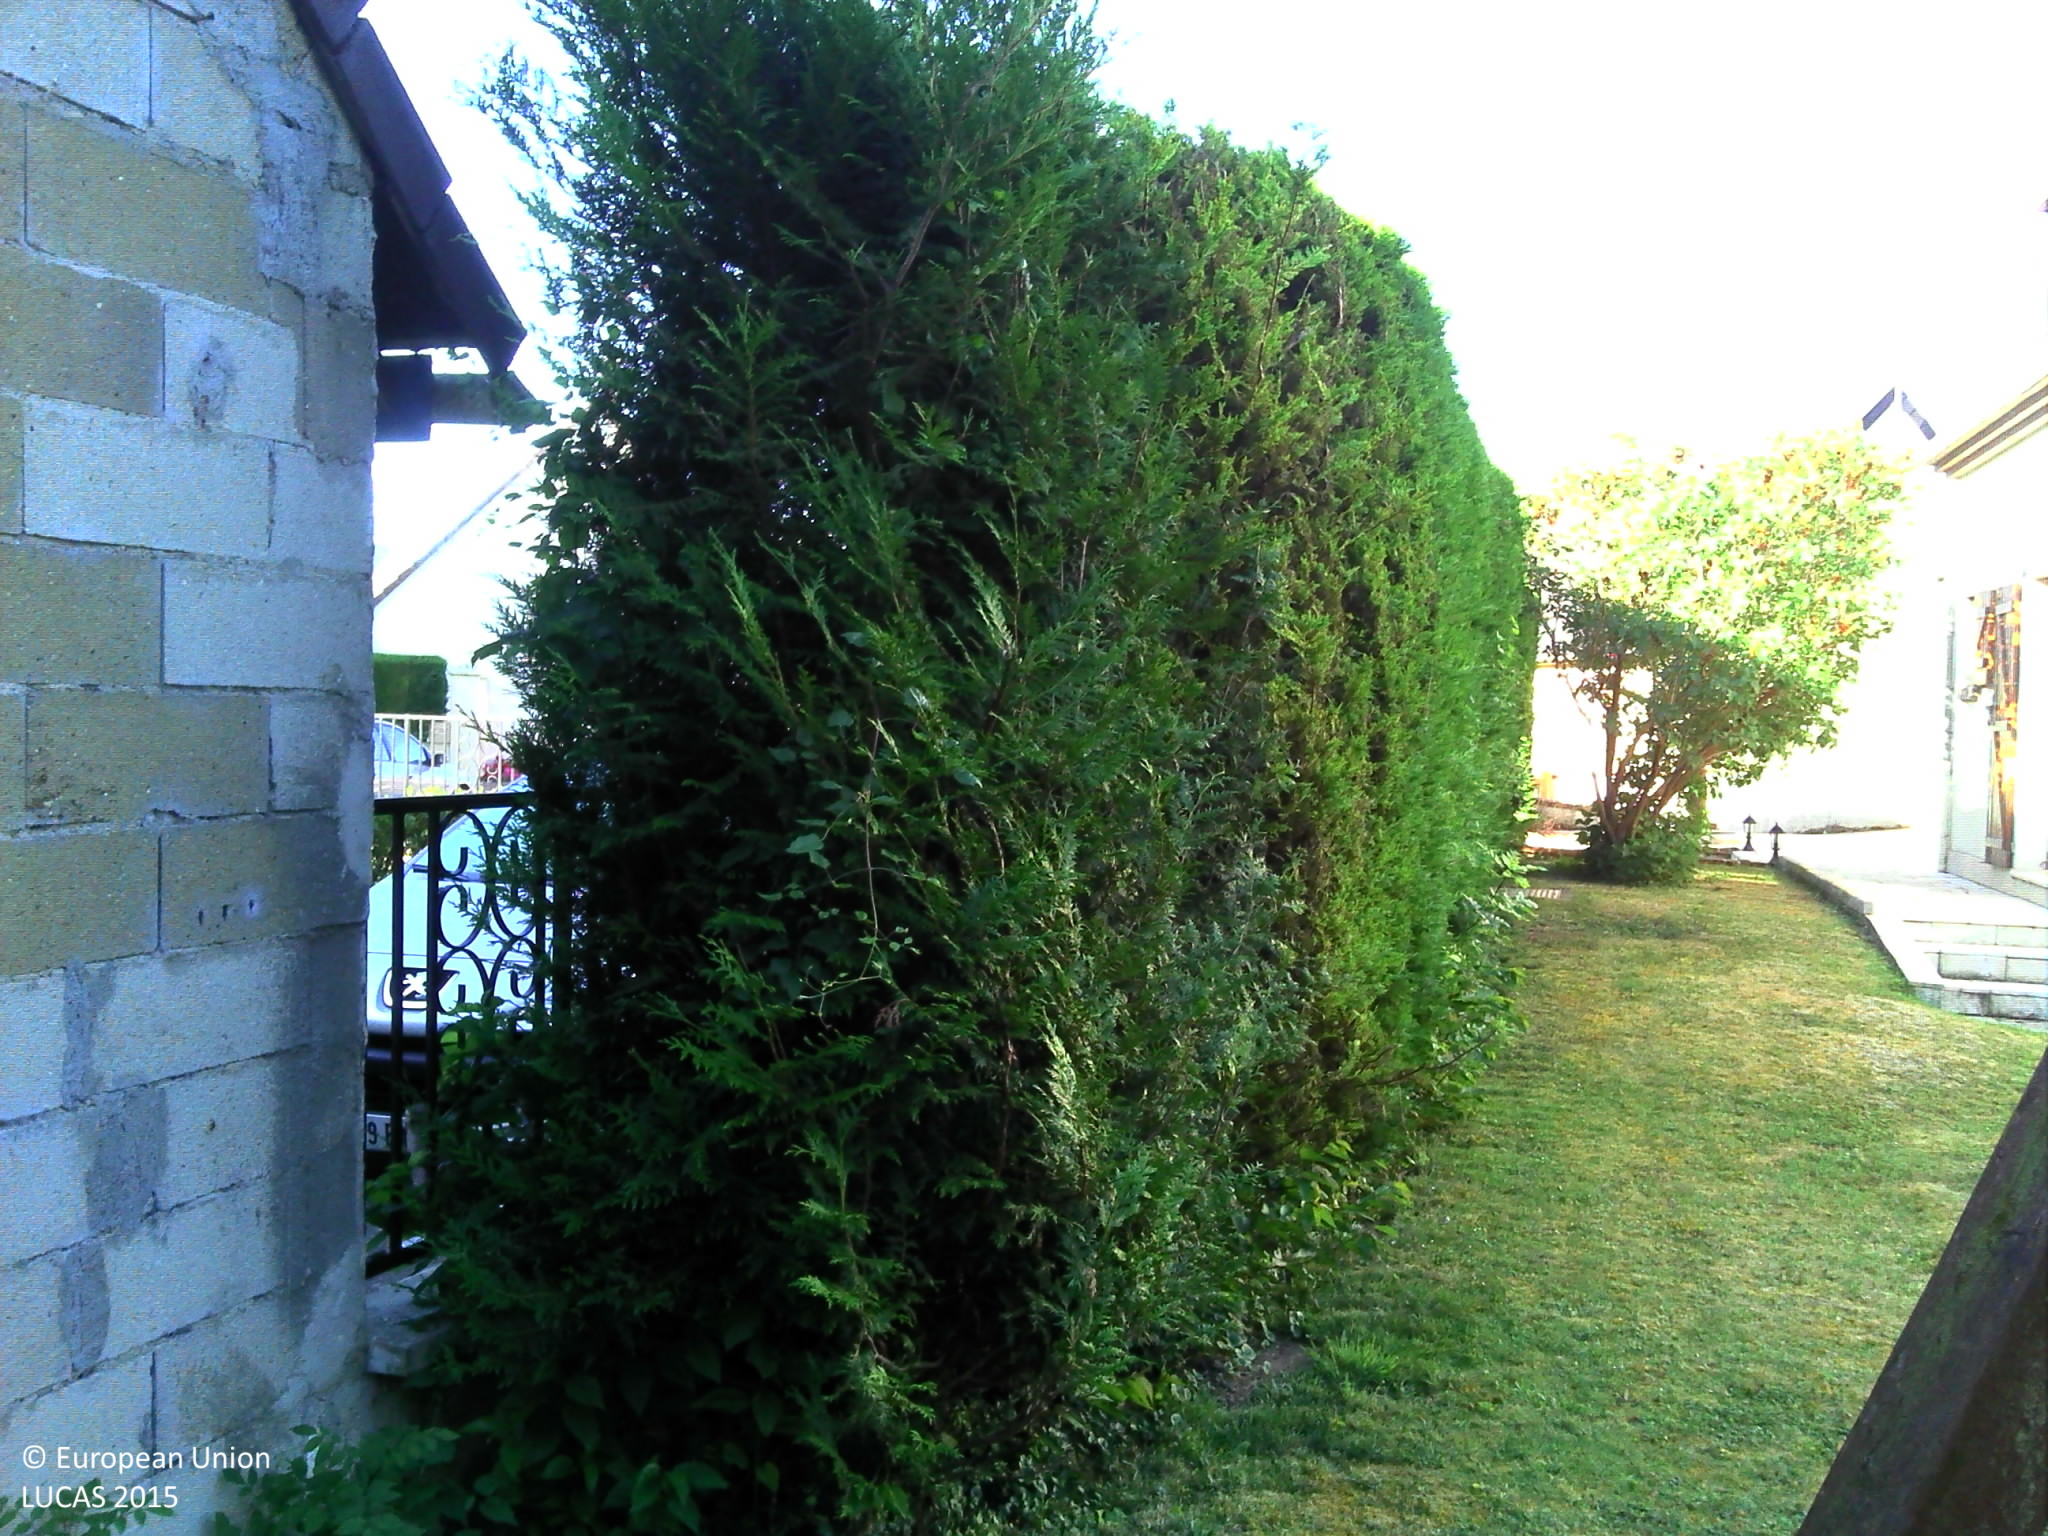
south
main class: Grassland
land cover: Grassland with sparse tree/shrub cover
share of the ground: > 75 %
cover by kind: herbaceous plants 95 %, coniferous forest trees 5 %
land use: Residential
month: June
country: FR
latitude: 49.4560
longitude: 2.3305
